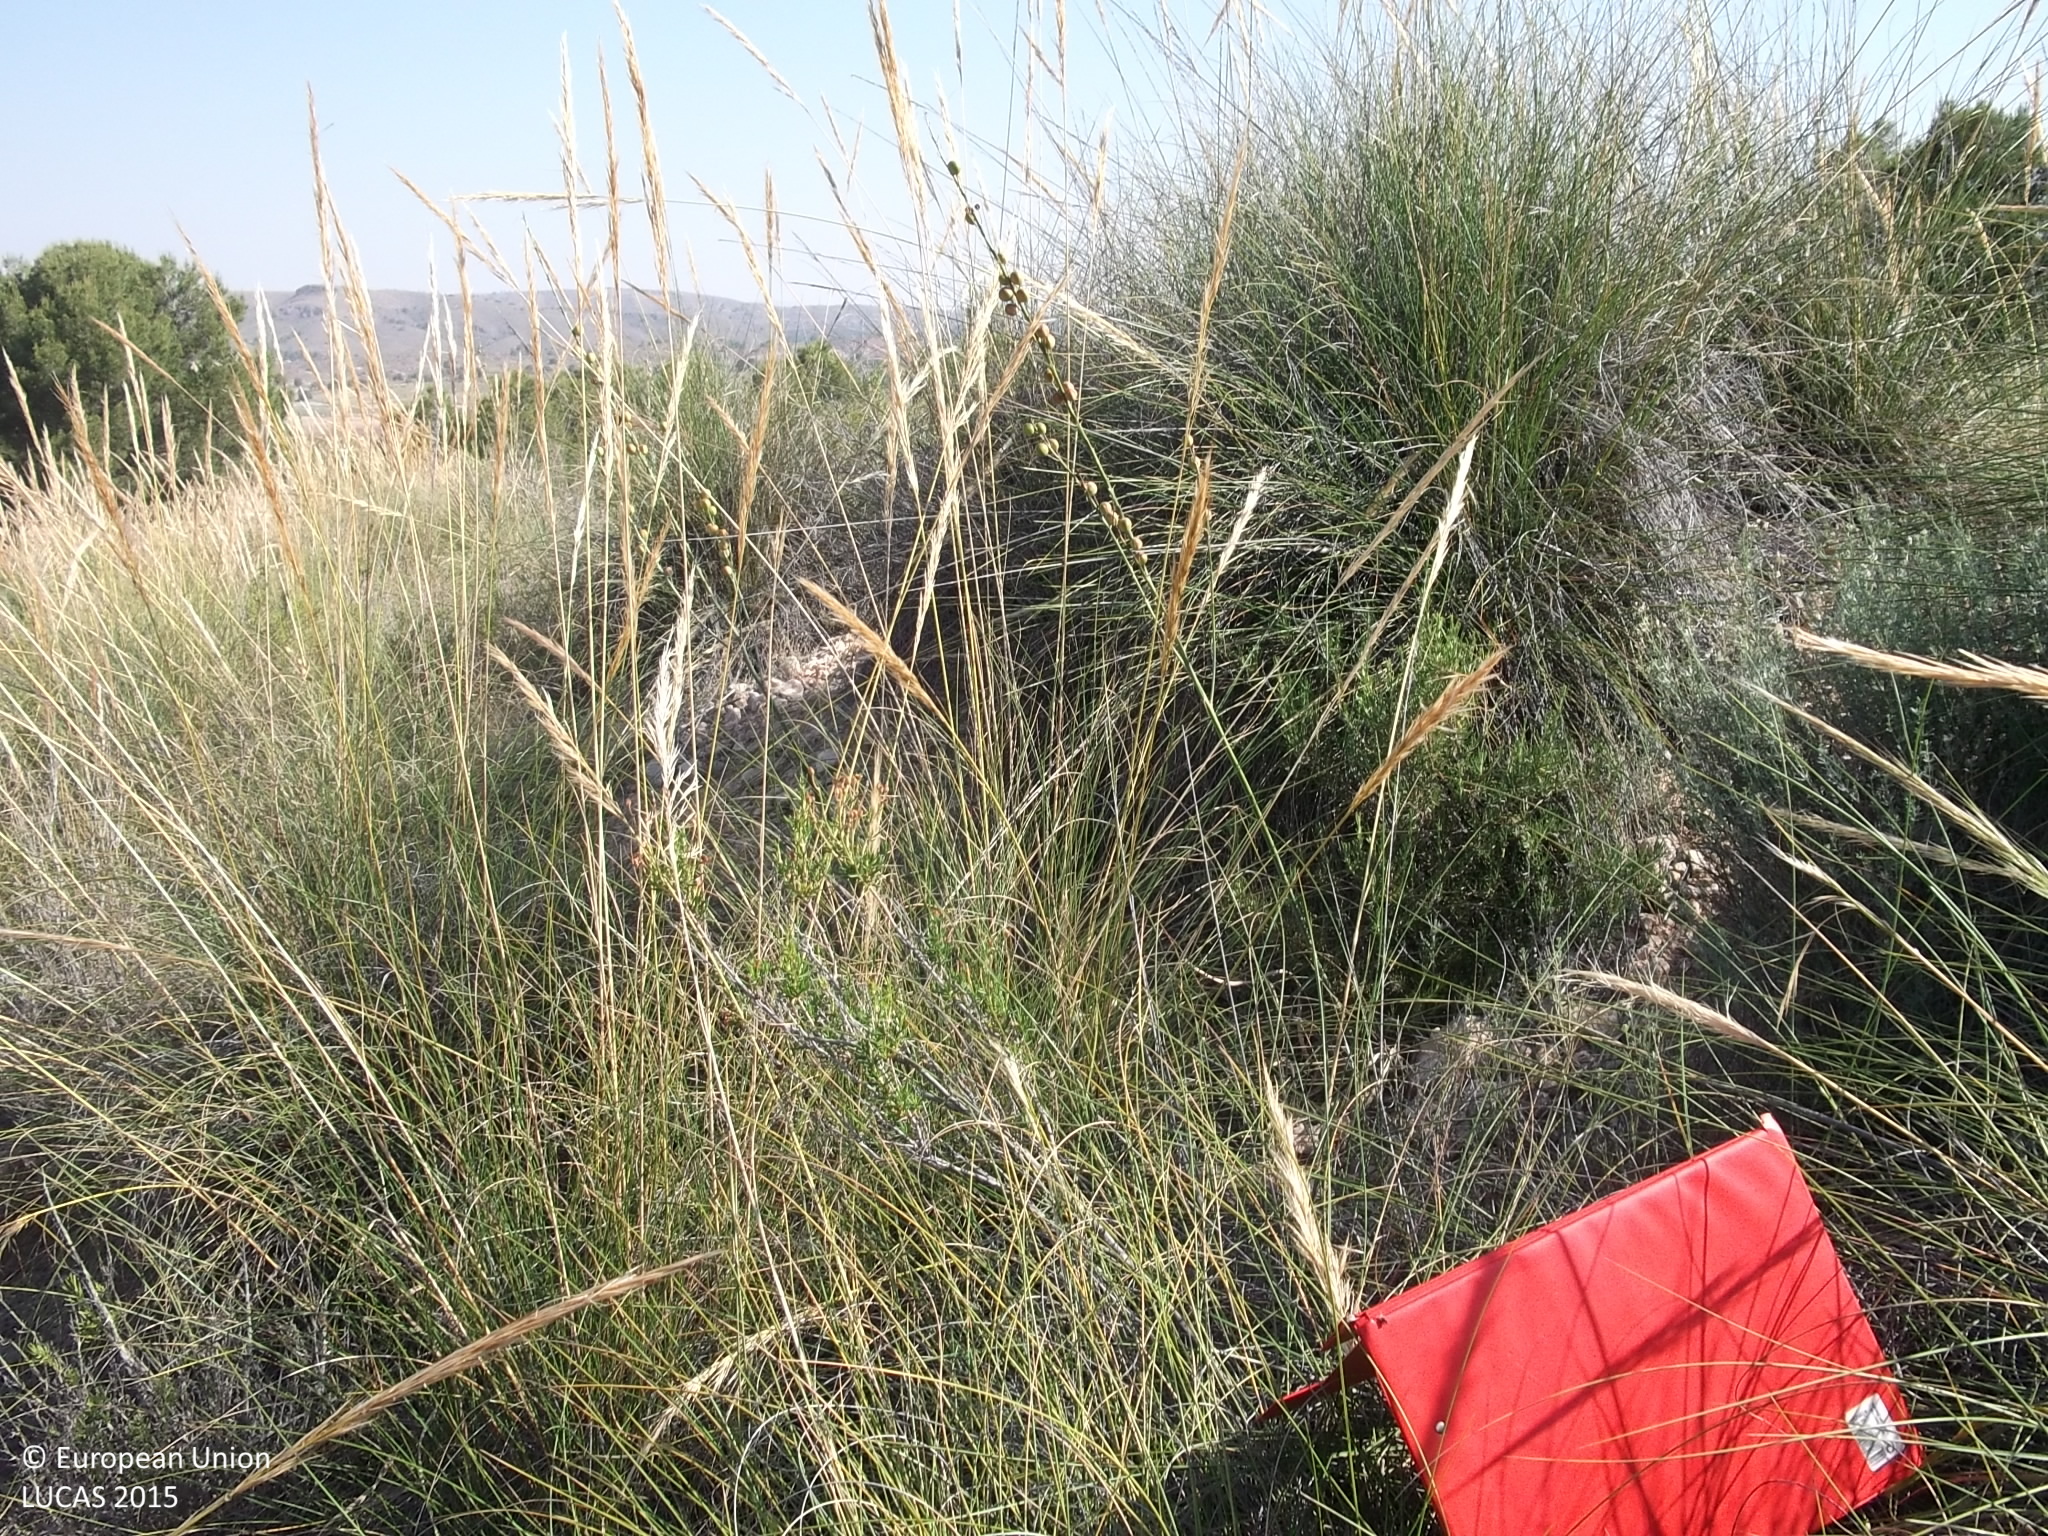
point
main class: Shrubland
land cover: Shrubland without tree cover
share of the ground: 50 - 75 %
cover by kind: shrubs 60 %, herbaceous plants 20 %, consolidated bare surface 20 %
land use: Semi-natural and natural areas not in use
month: May
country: ES
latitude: 38.4371
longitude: -1.5050
